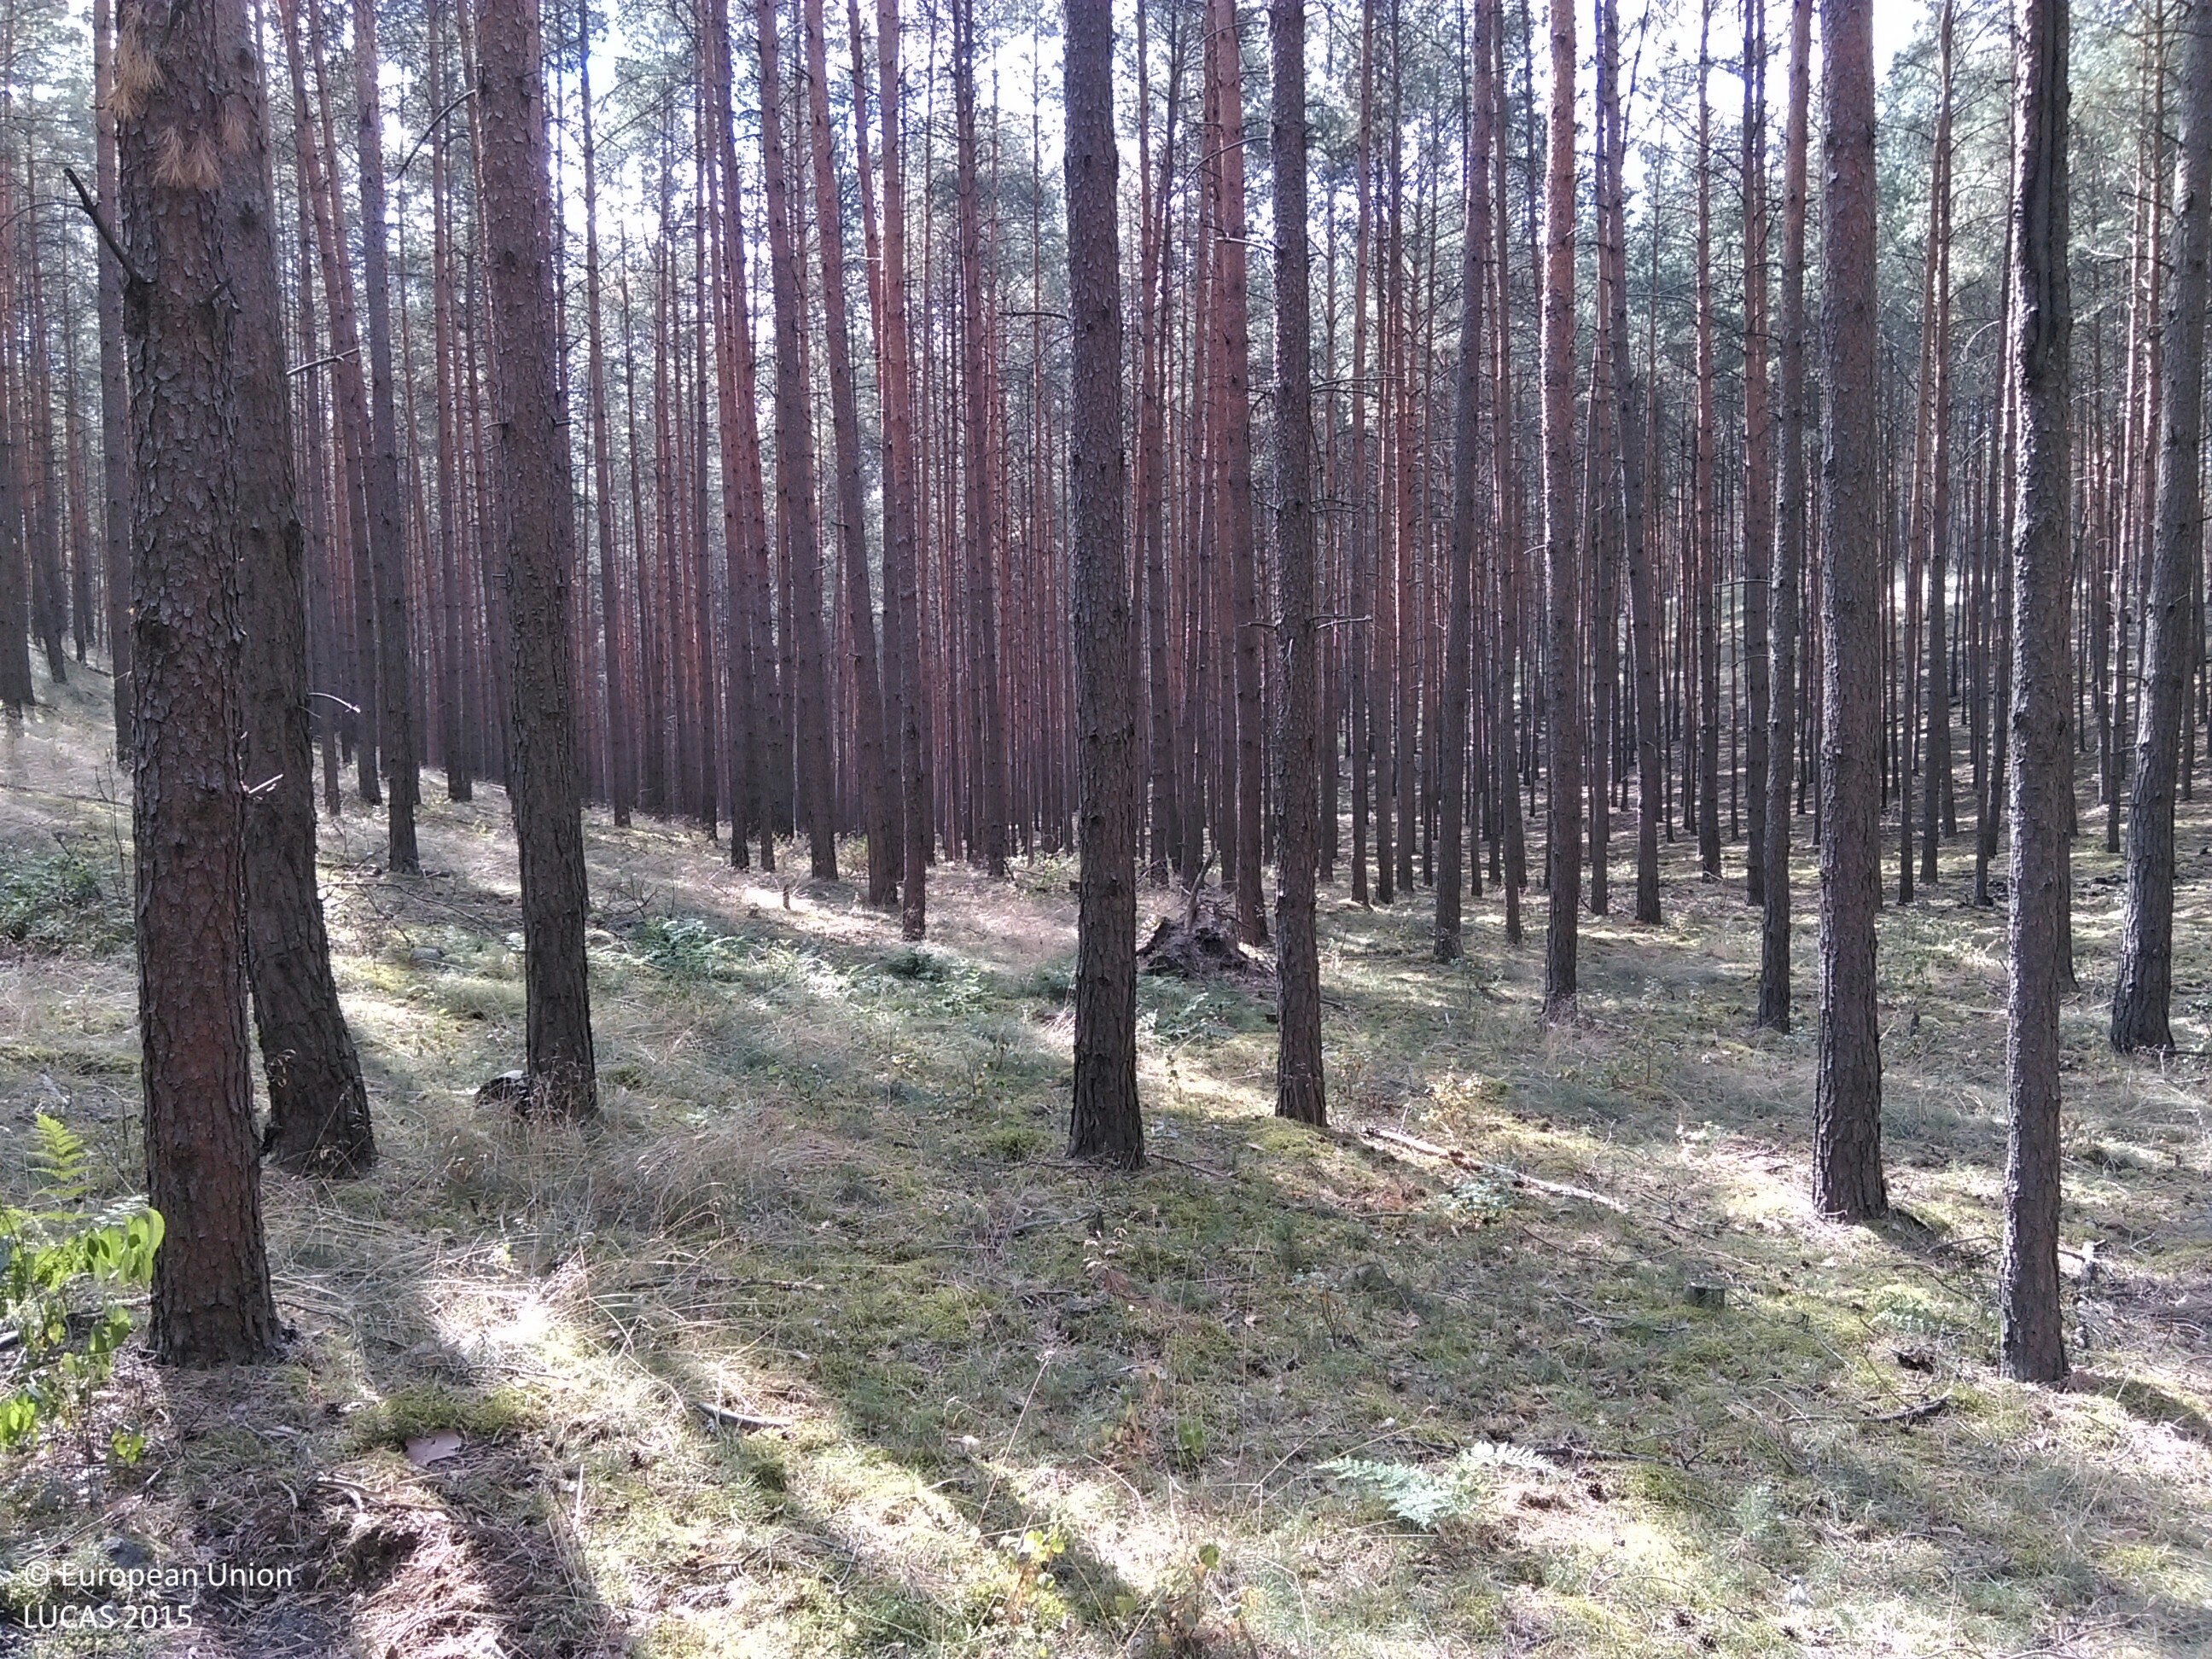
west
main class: Woodland
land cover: Pine dominated coniferous woodland
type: hemiboreal forest and nemoral coniferous forest and mixed broadleaved-coniferous forest
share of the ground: > 75 %
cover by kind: coniferous forest trees 80 %, lichens and mosses 20 %
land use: Forestry
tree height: > 5 m
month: August
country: PL
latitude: 52.2089
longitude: 15.6092
